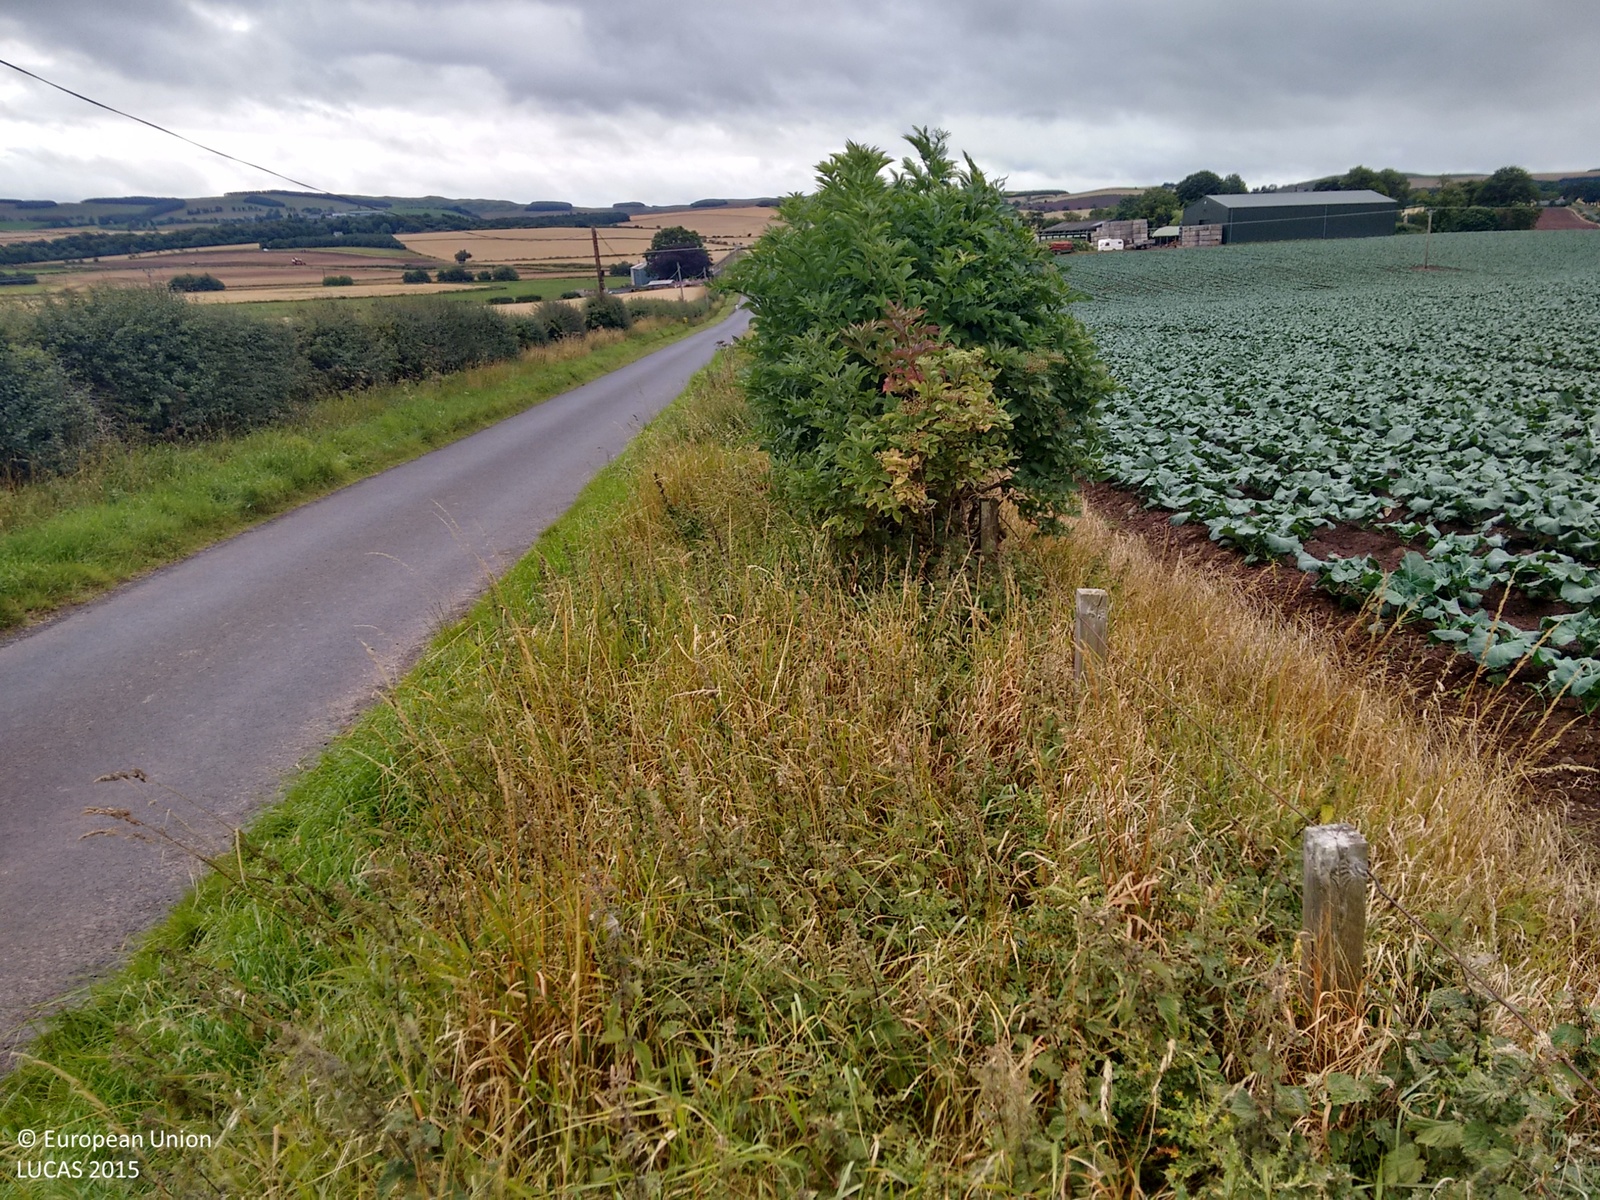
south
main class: Cropland
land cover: Other fresh vegetables
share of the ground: > 75 %
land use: Agriculture (excluding fallow land and kitchen gardens)
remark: Tilled/Sowed
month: August
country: GB
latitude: 55.5287
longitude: -2.4004
